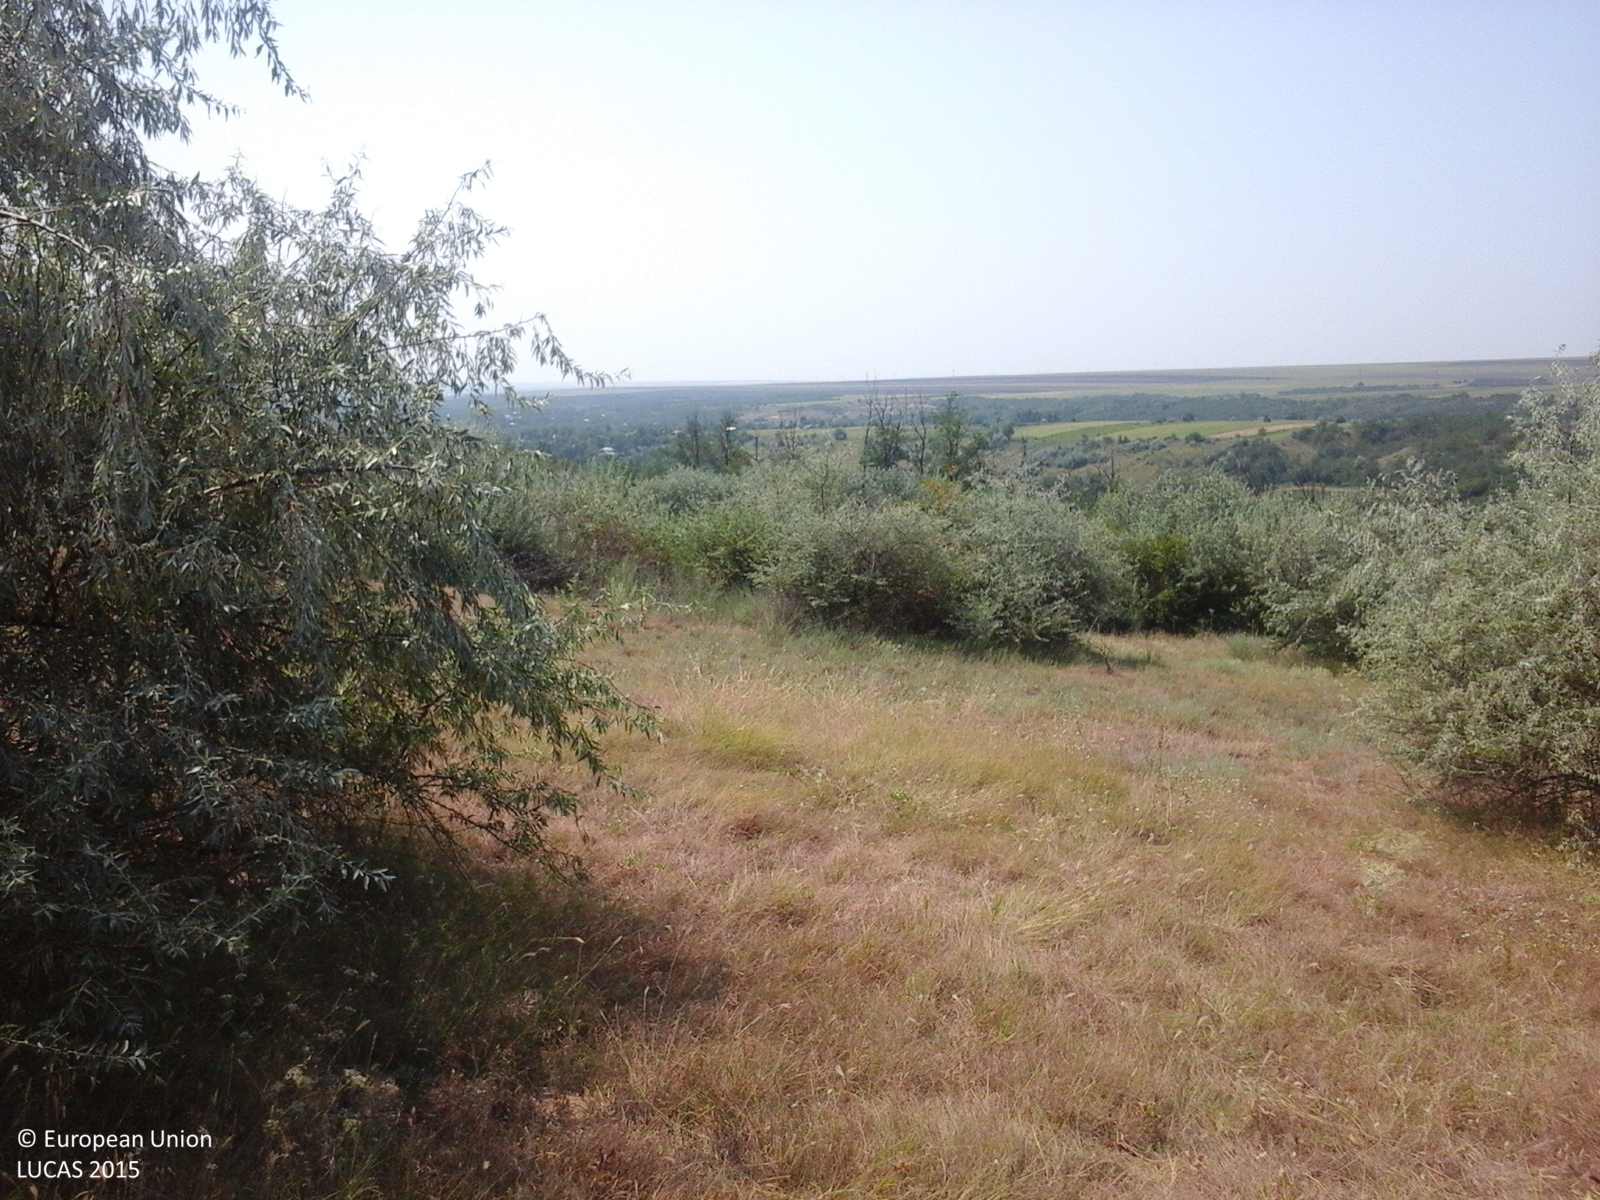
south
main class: Grassland
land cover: Grassland with sparse tree/shrub cover
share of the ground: > 75 %
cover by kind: herbaceous plants 95 %, broadleaved forest trees 5 %
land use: Semi-natural and natural areas not in use
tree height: < 5 m
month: July
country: RO
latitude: 45.9613
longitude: 27.9396
